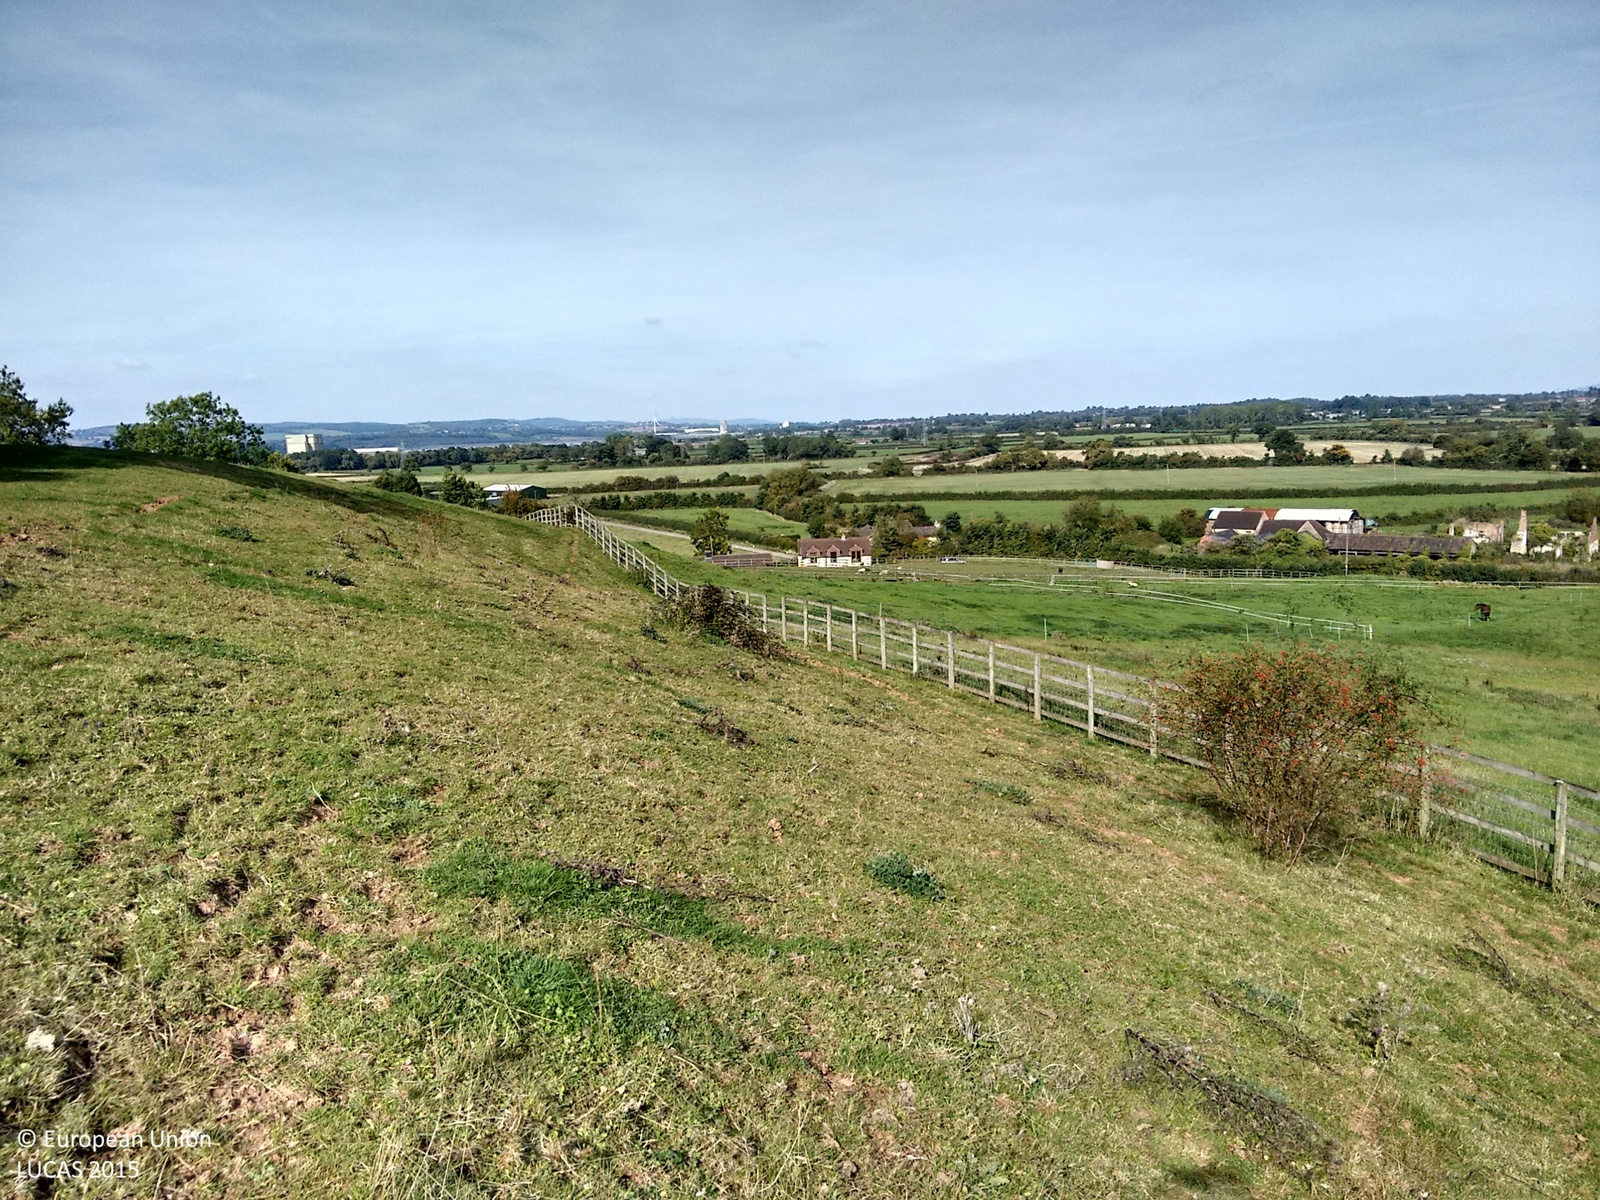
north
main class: Grassland
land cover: Grassland without tree/shrub cover
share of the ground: > 75 %
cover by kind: herbaceous plants 100 %
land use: Agriculture (excluding fallow land and kitchen gardens)
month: September
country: GB
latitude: 51.6783
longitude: -2.4893
